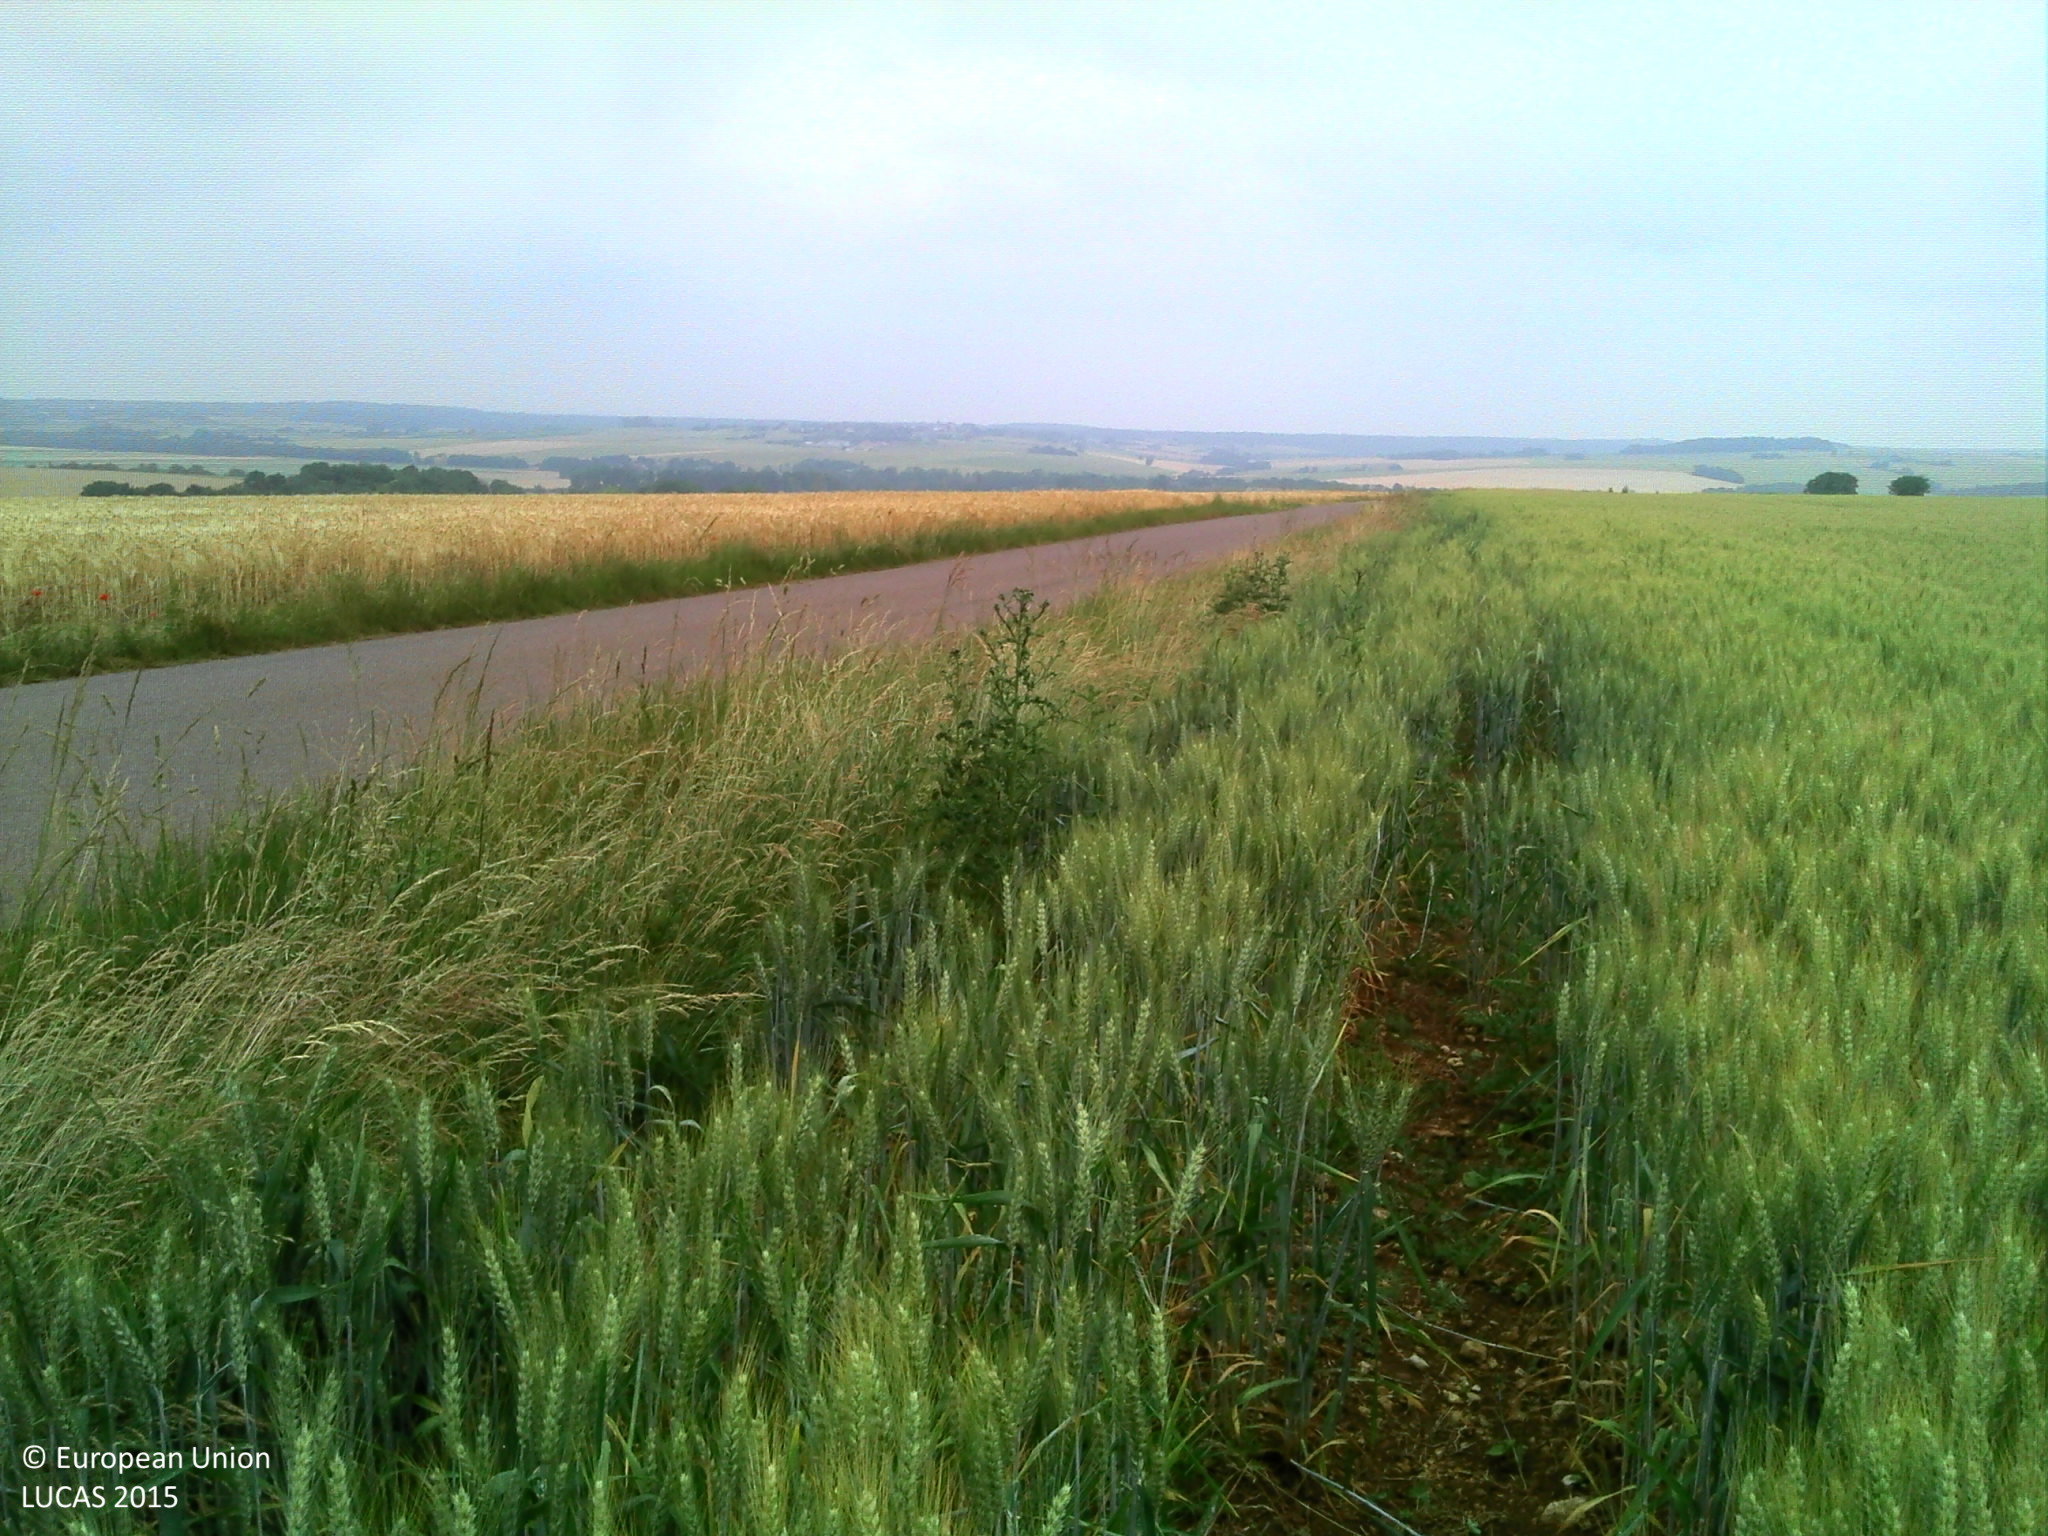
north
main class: Cropland
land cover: Common wheat
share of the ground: > 75 %
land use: Agriculture (excluding fallow land and kitchen gardens)
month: June
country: FR
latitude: 47.9108
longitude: 3.9089
